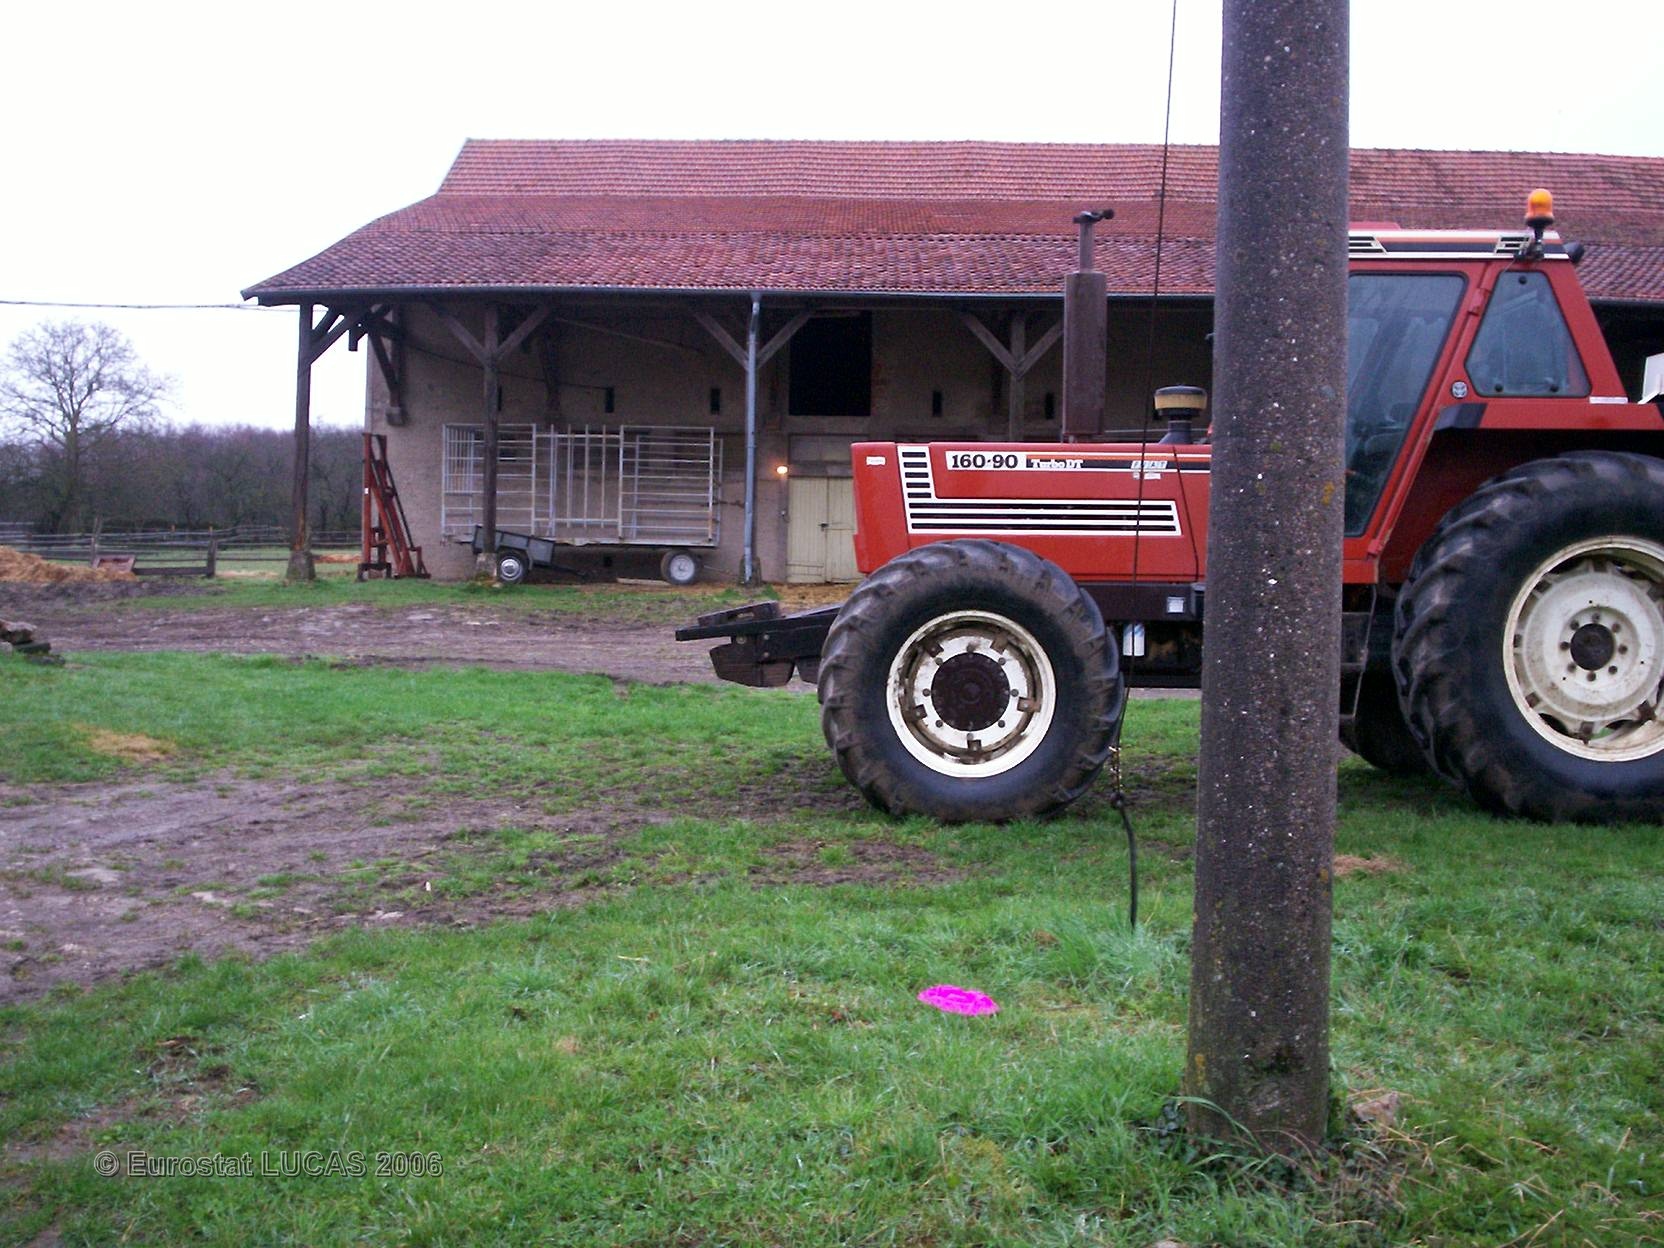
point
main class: Grassland
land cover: Grassland without tree/shrub cover
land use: Agriculture (excluding fallow land and kitchen gardens)
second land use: Residential
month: April
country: FR
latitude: 48.7228
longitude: 6.9964
